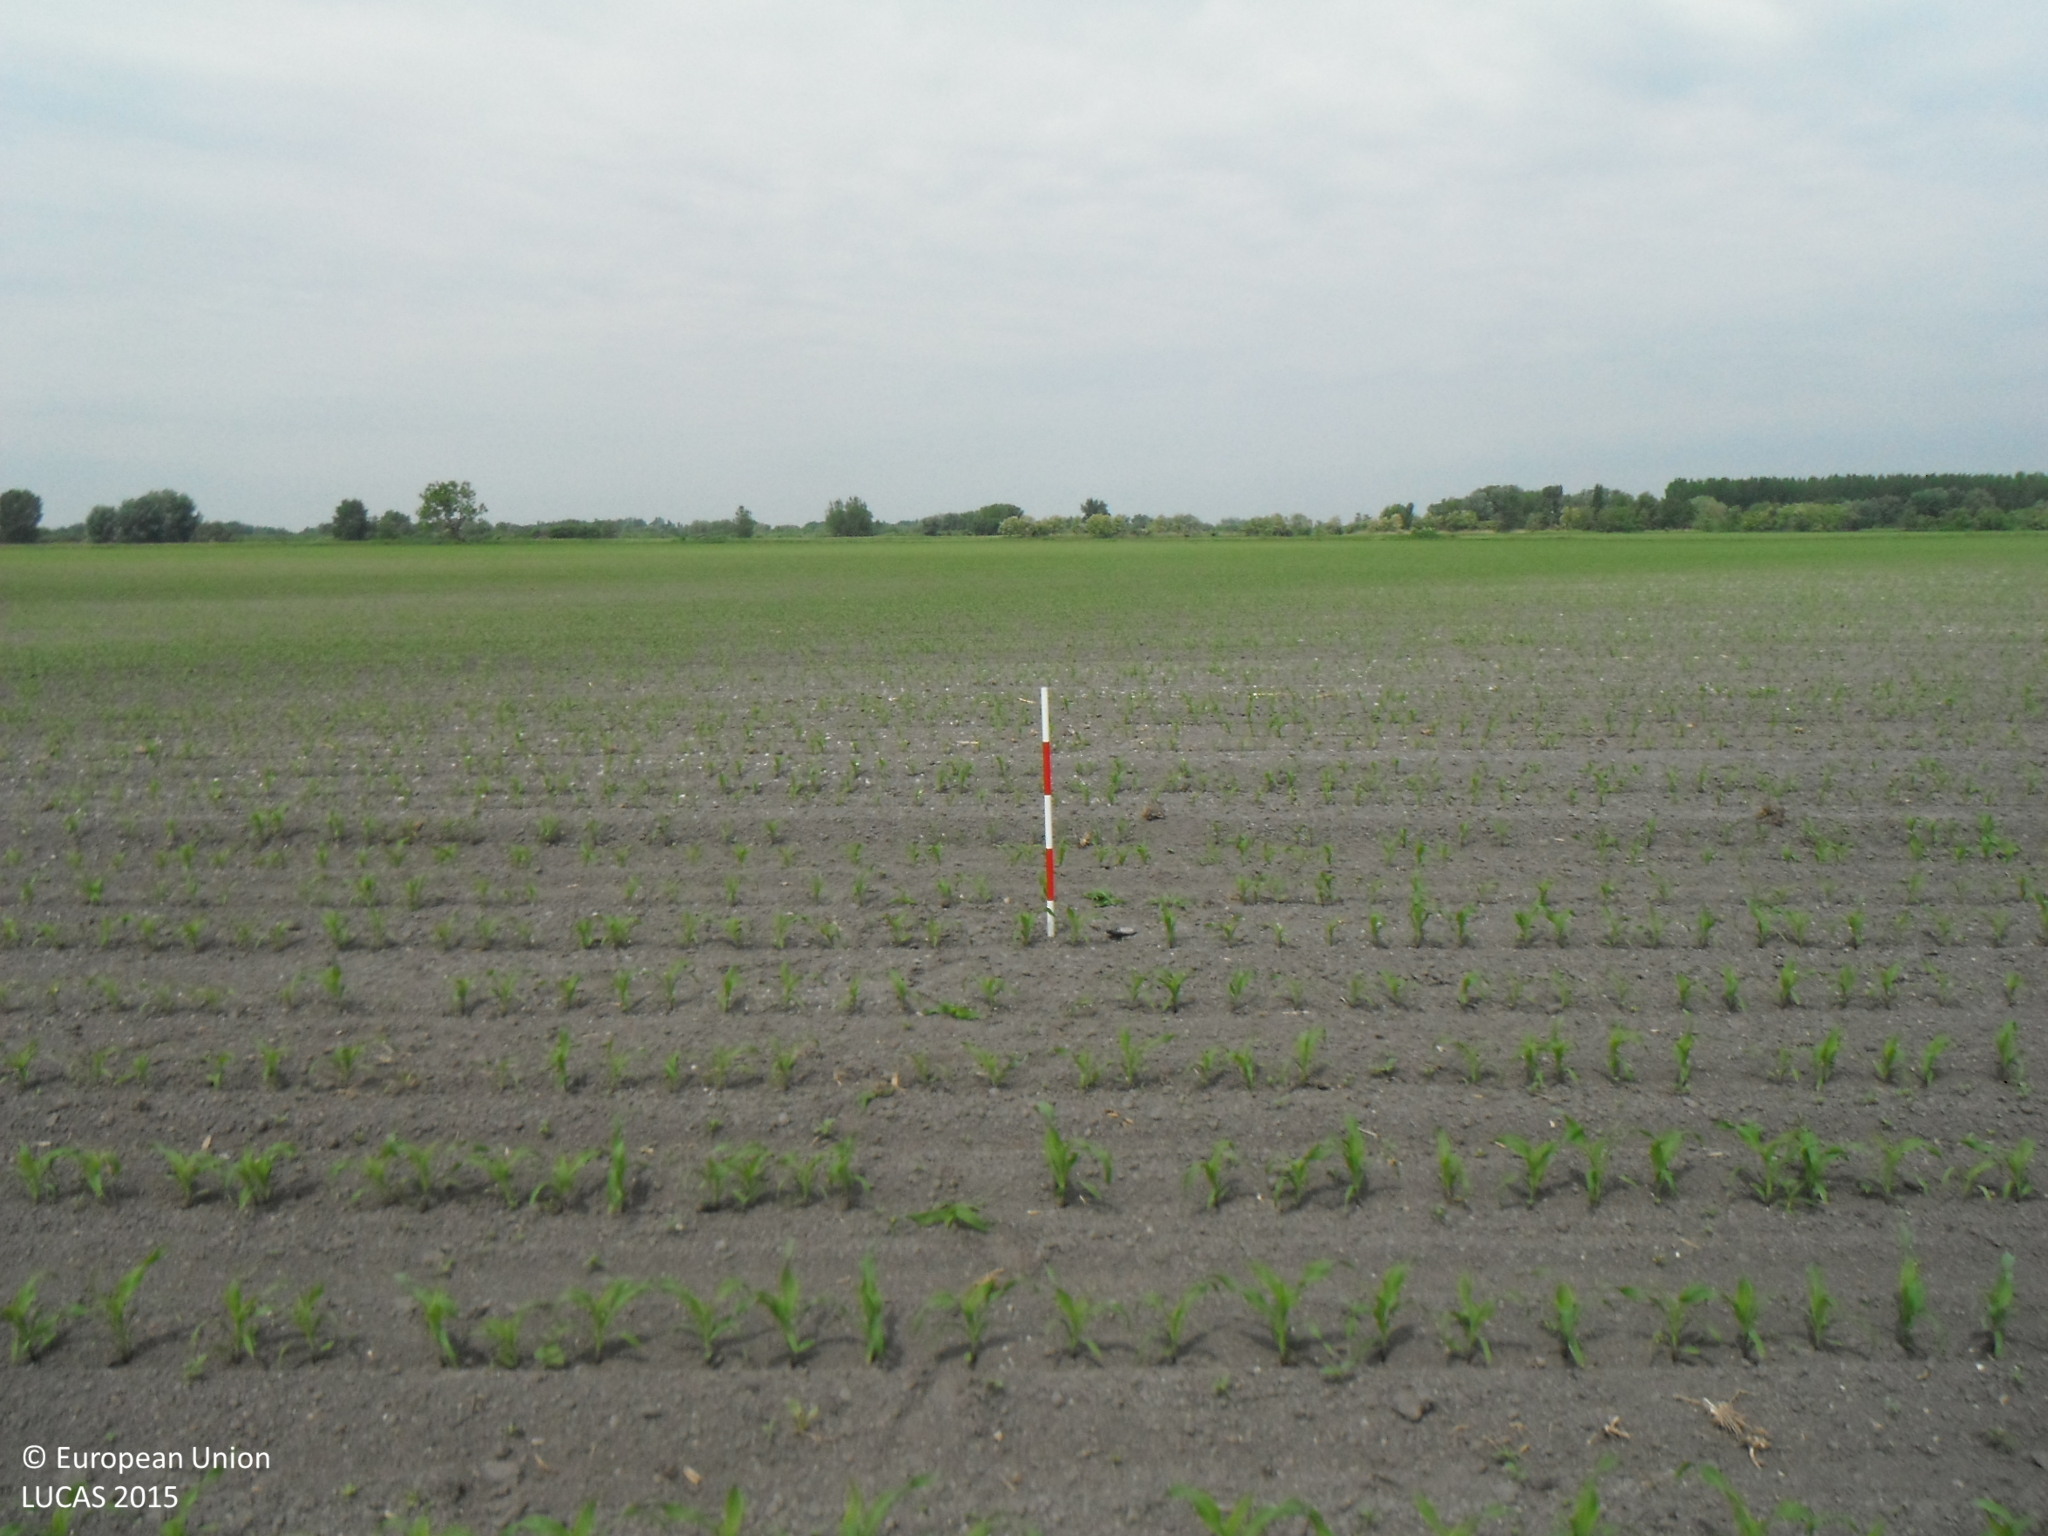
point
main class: Cropland
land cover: Maize
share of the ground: < 10 %
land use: Agriculture (excluding fallow land and kitchen gardens)
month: May
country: SK
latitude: 47.8978
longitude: 17.7285
